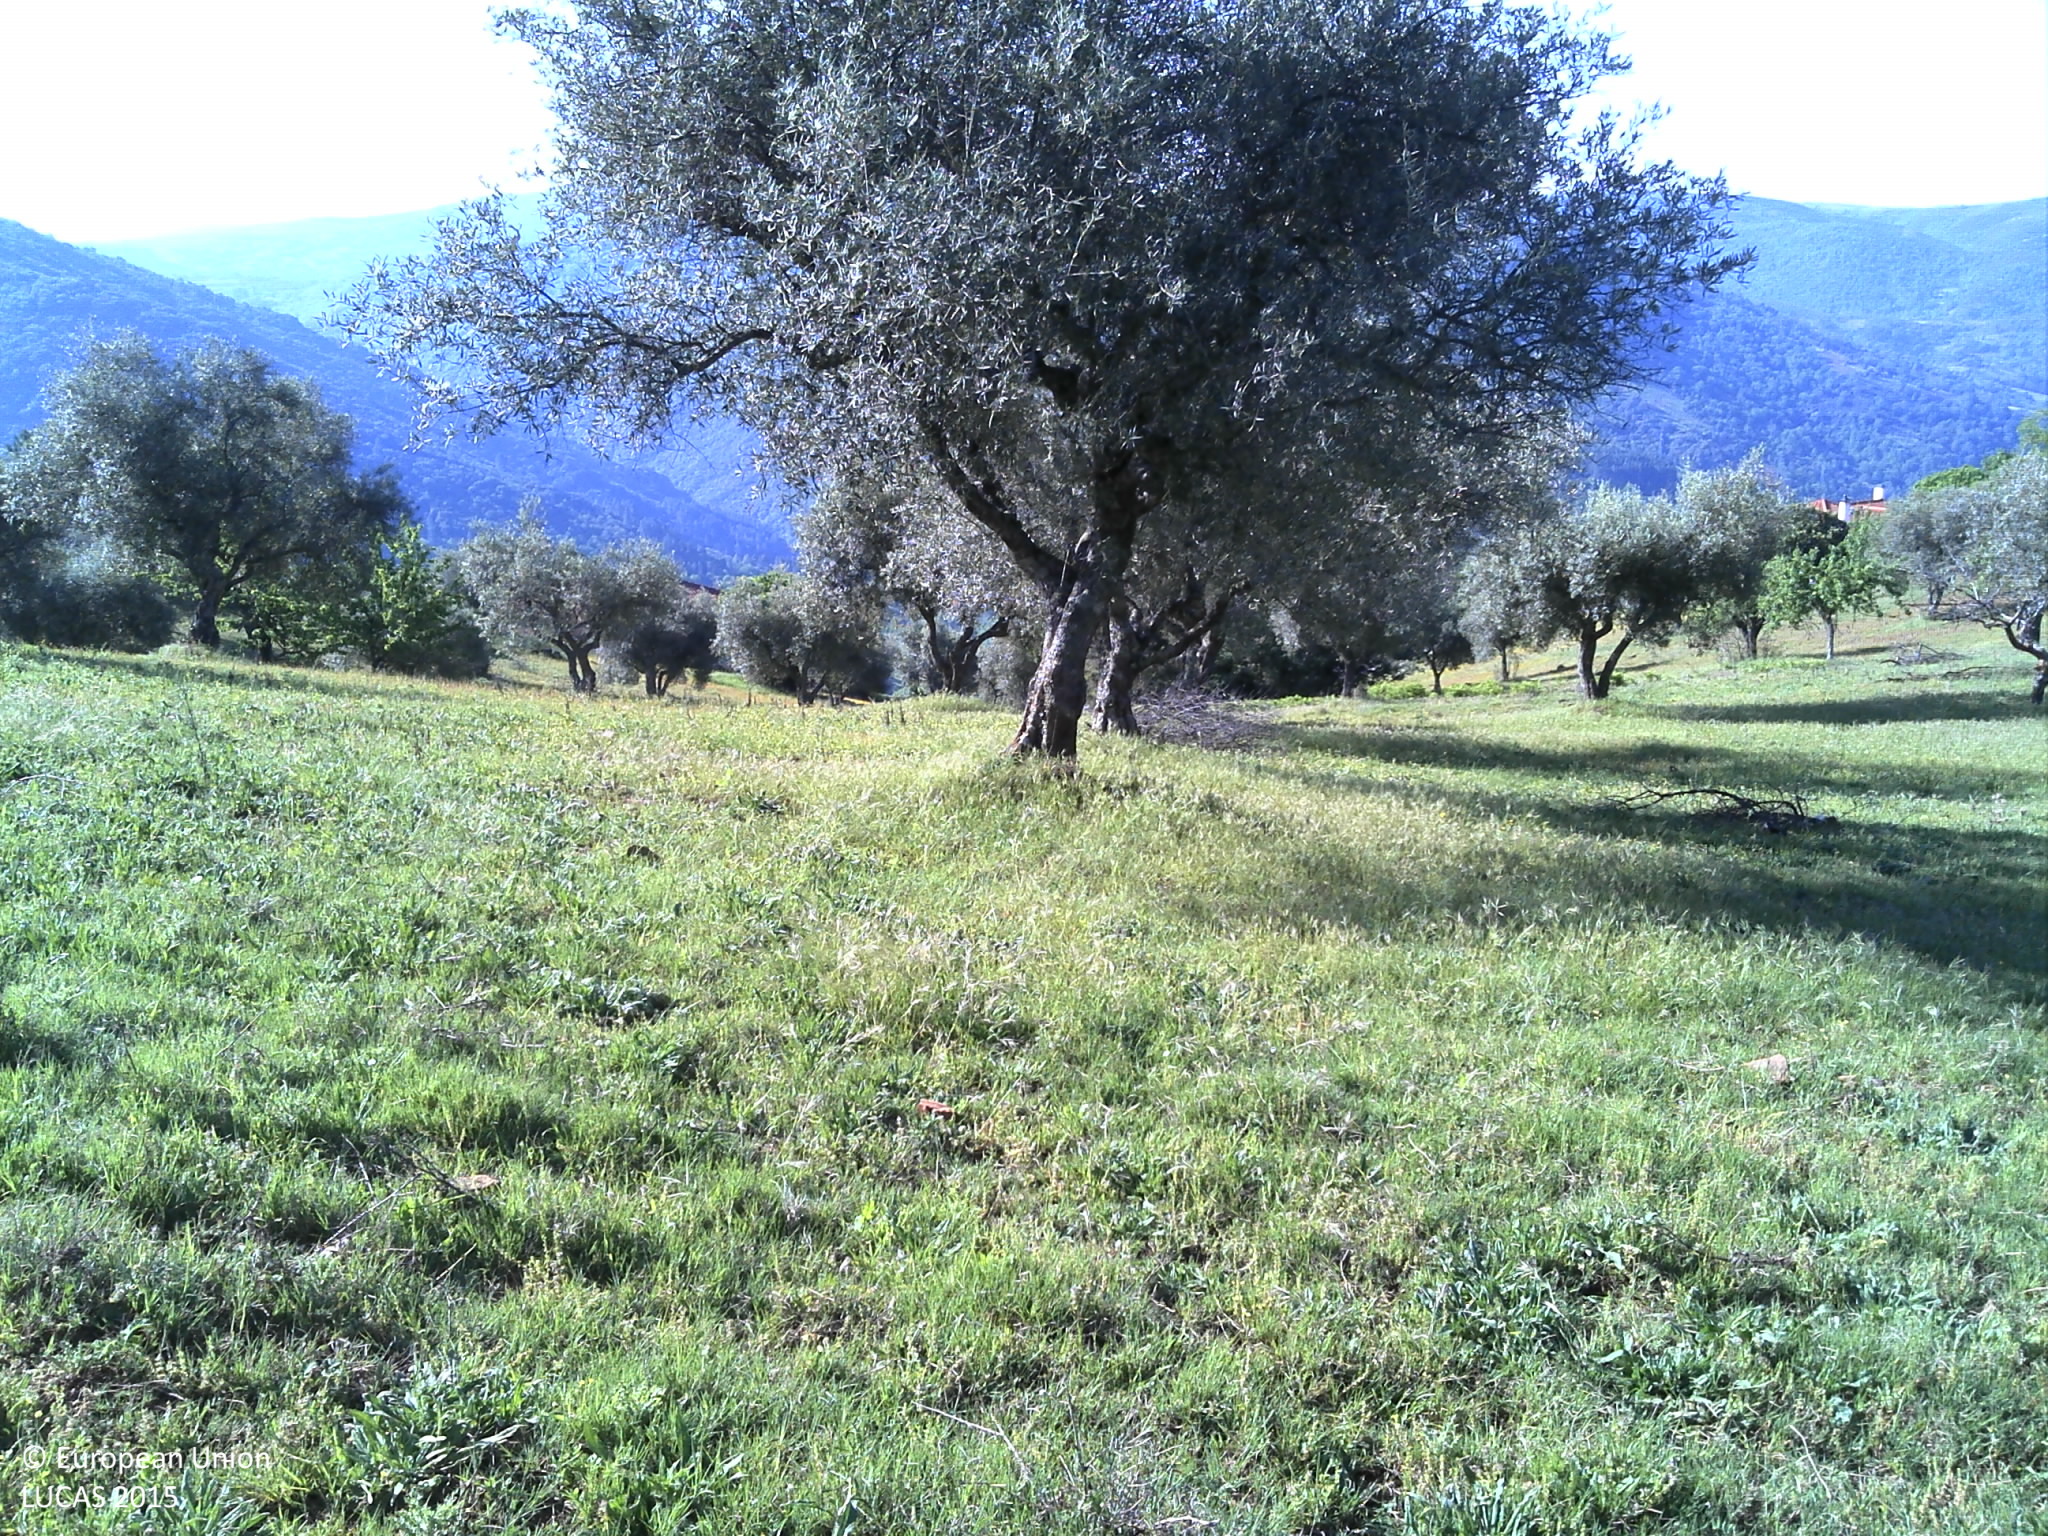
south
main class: Cropland
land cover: Olive groves
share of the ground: 10 - 25 %
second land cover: Grassland without tree/shrub cover
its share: 50 - 75 %
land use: Agriculture (excluding fallow land and kitchen gardens)
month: May
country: PT
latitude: 41.8325
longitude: -6.9890
